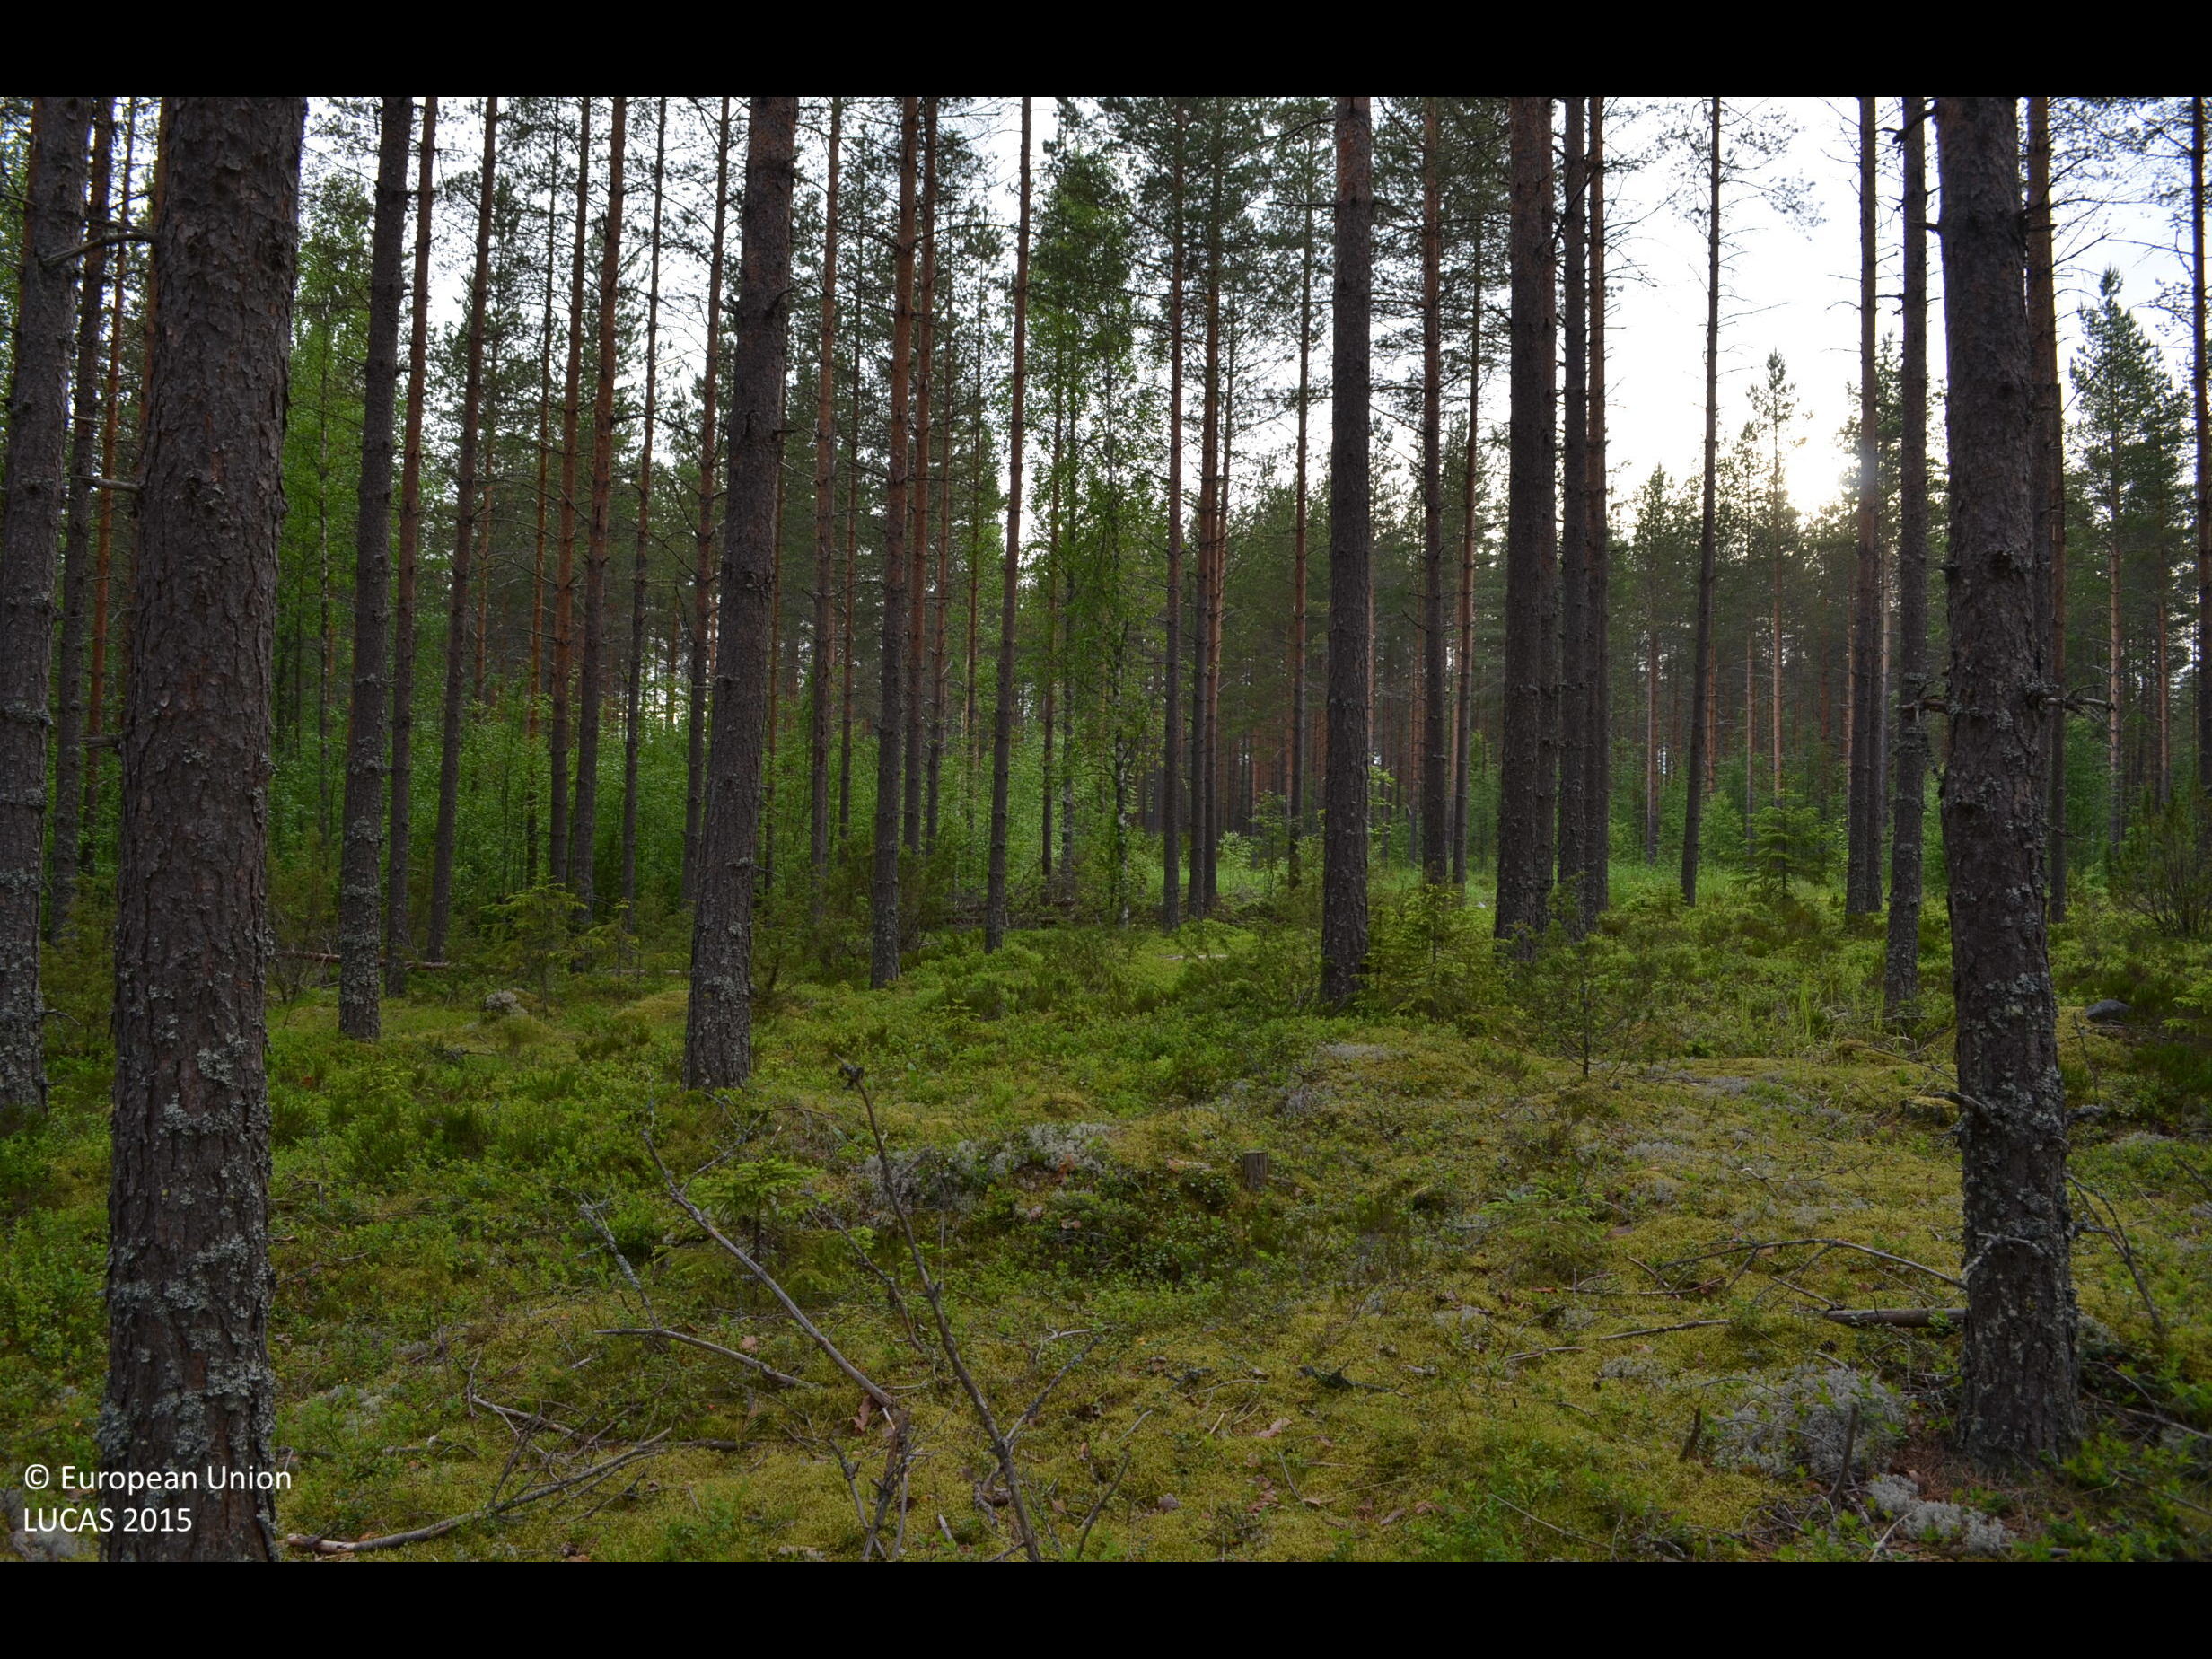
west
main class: Woodland
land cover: Pine dominated coniferous woodland
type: boreal forest
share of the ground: > 75 %
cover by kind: coniferous forest trees 75 %, shrubs 20 %, lichens and mosses 5 %
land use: Forestry
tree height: > 5 m
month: June
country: FI
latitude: 62.0855
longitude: 23.5749
